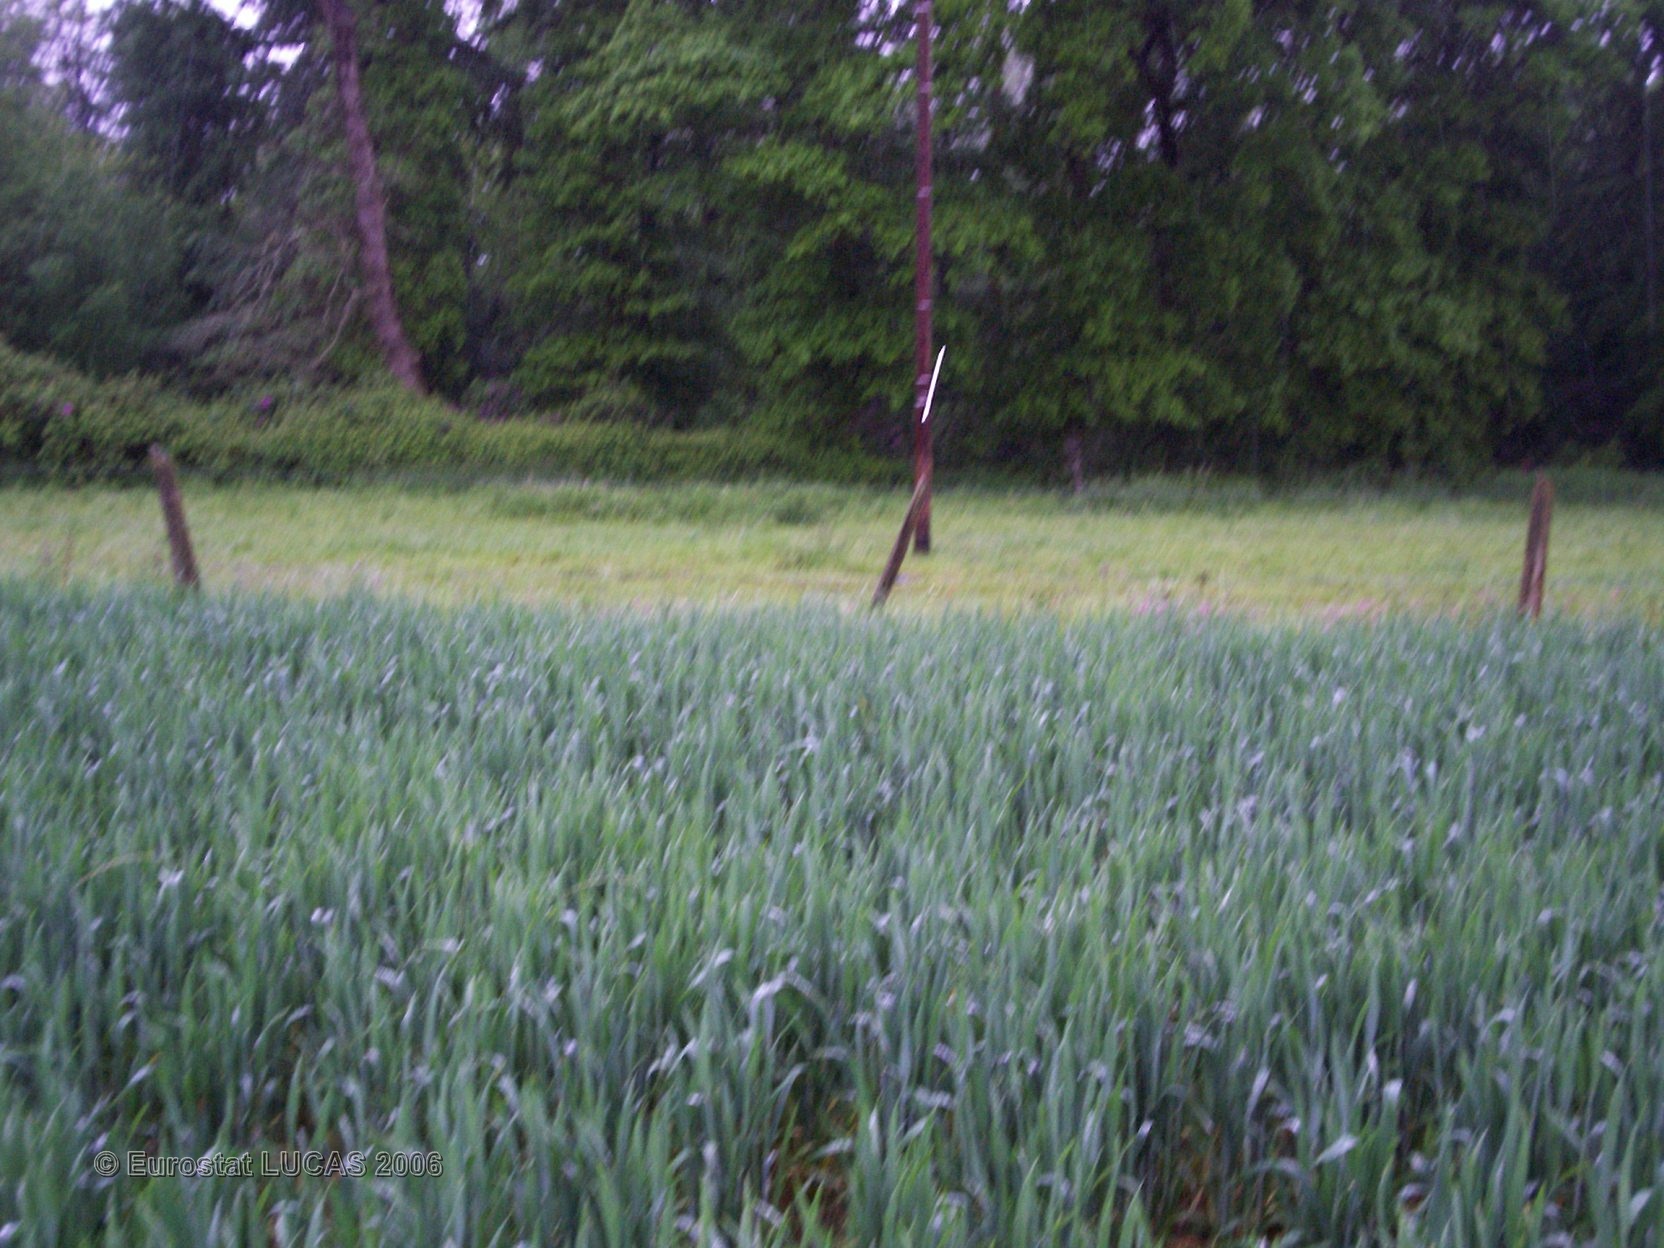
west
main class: Cropland
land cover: Common wheat
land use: Agriculture (excluding fallow land and kitchen gardens)
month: May
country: FR
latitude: 49.7298
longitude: 0.4696
